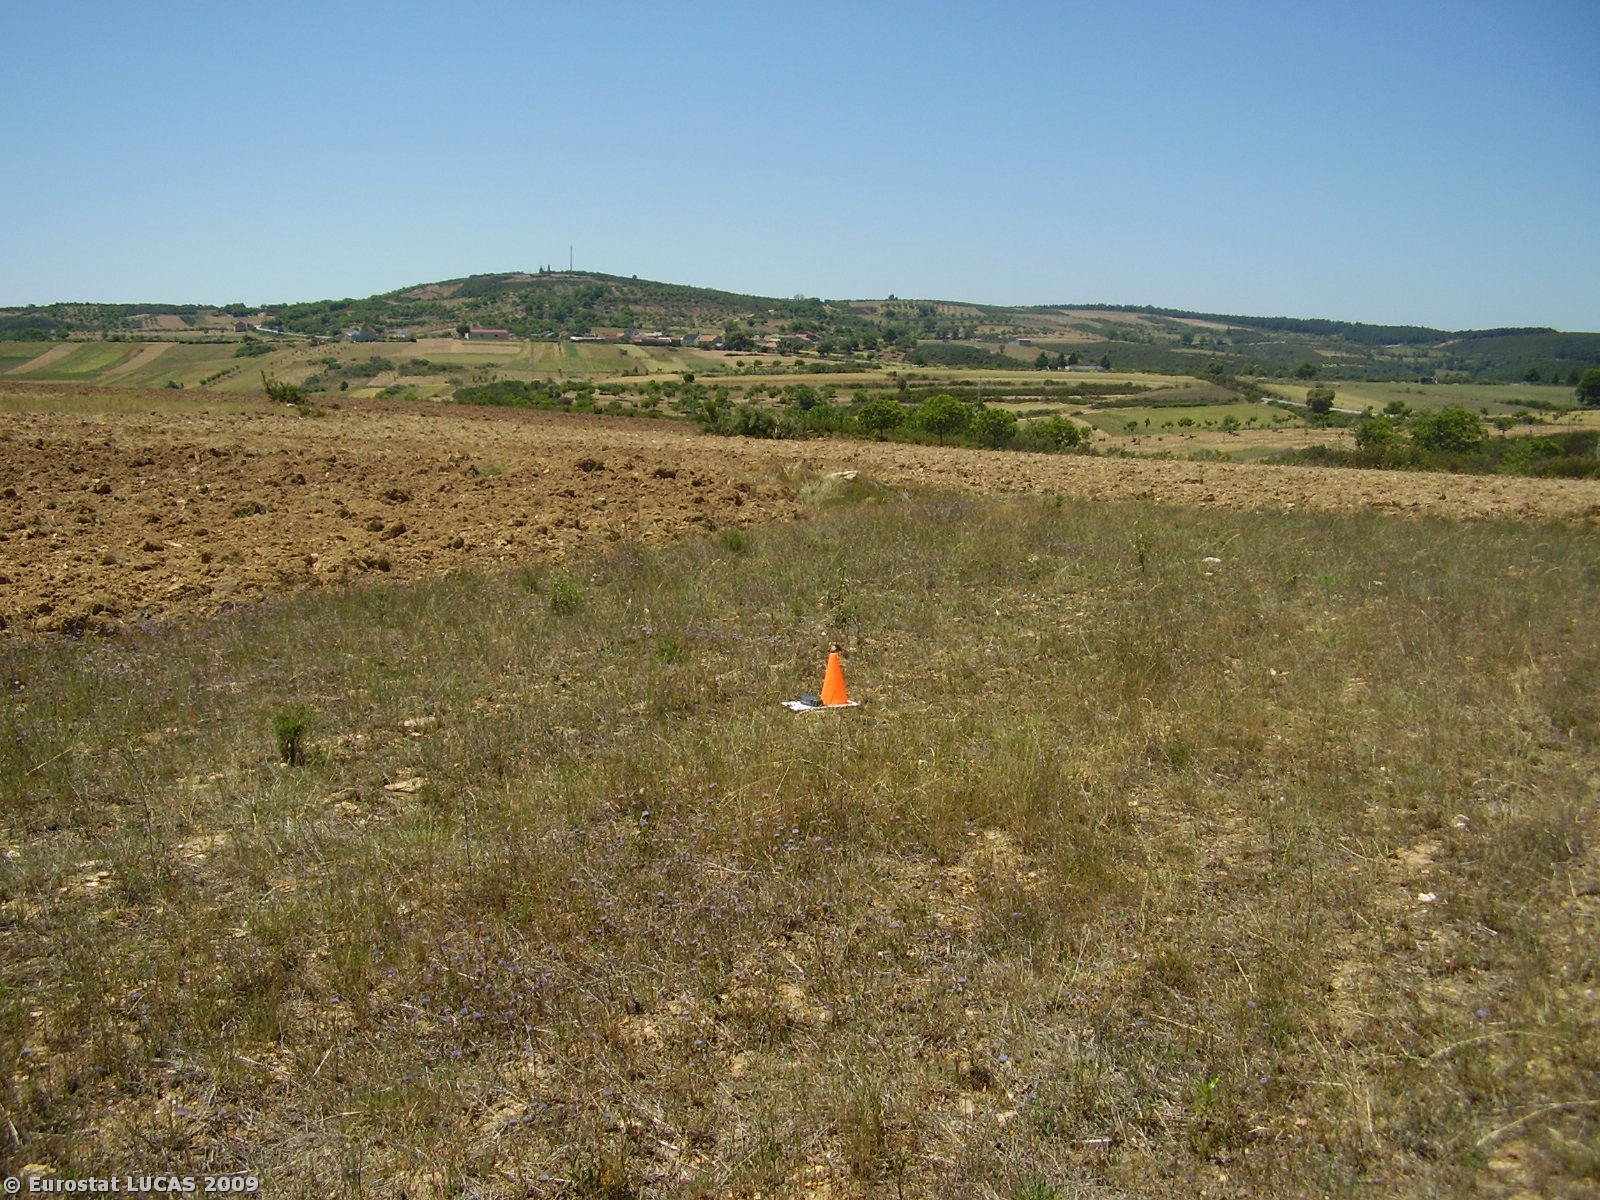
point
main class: Grassland
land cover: Spontaneously vegetated surfaces
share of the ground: 50 - 75 %
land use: Fallow land
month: June
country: PT
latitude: 41.8654
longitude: -6.5786
